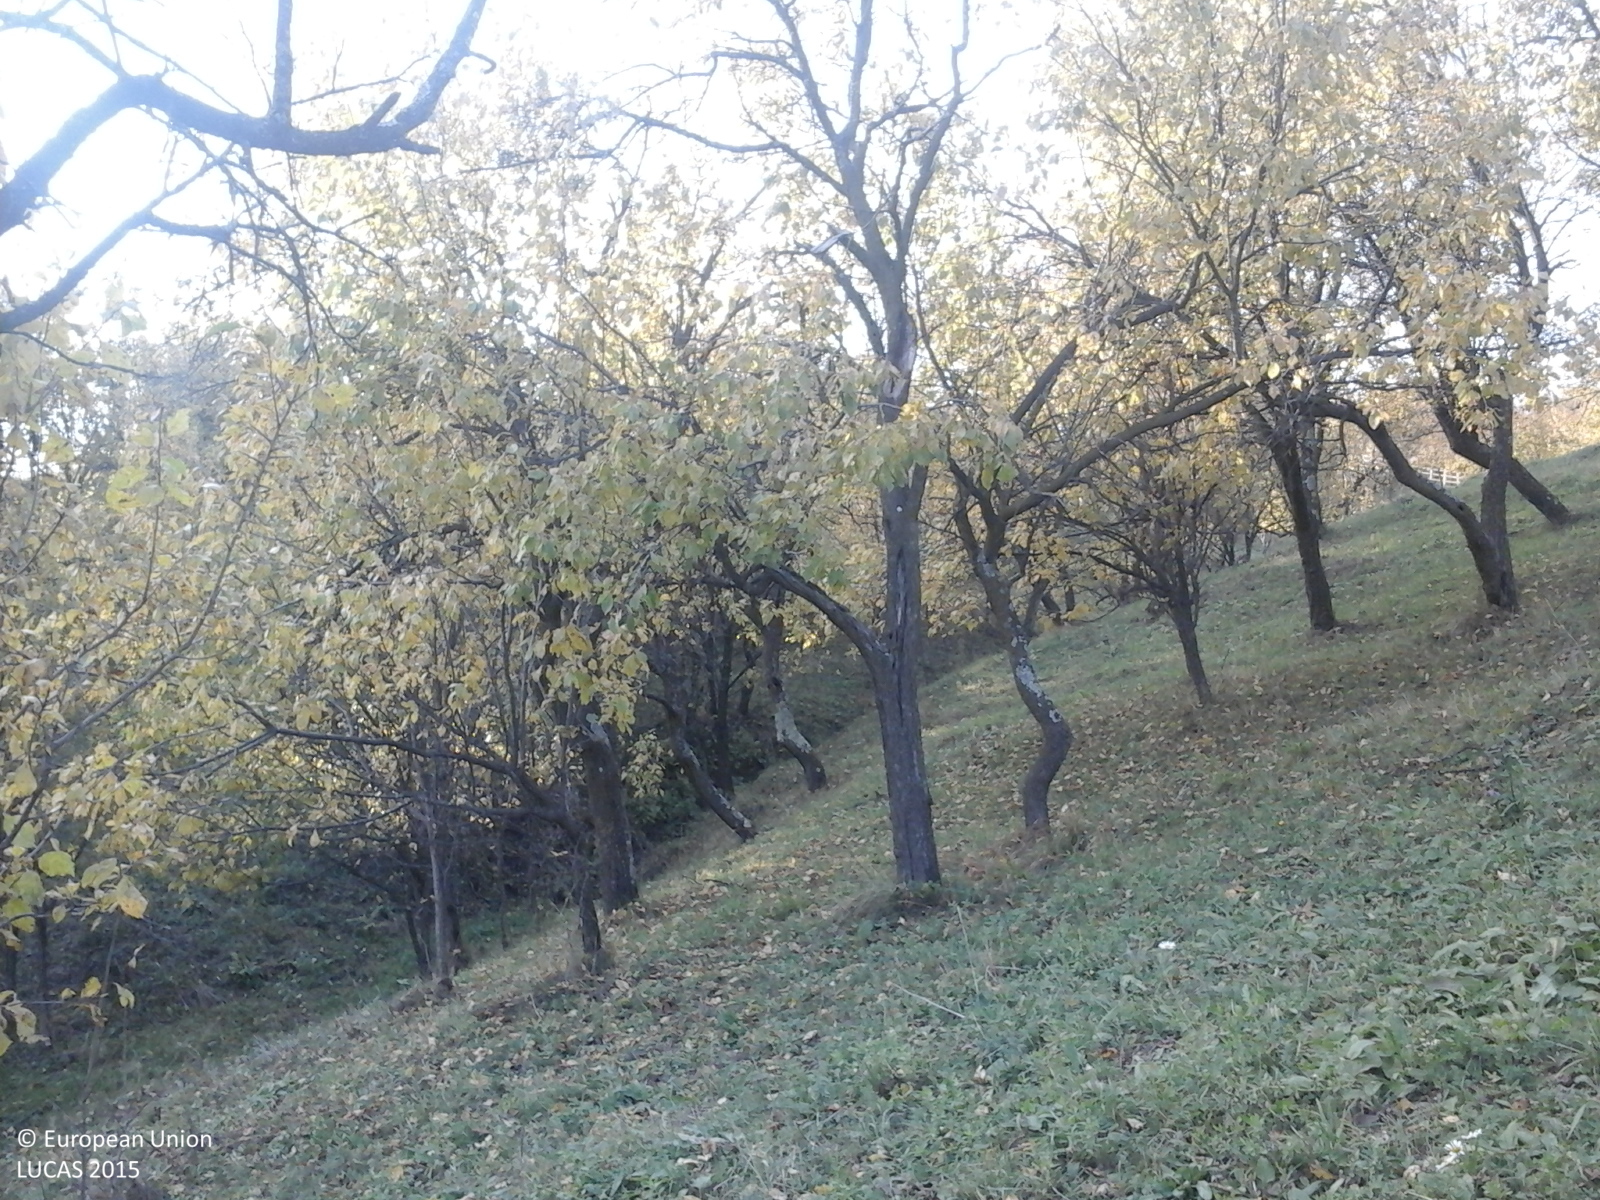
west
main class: Cropland
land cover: Other fruit trees and berries
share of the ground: > 75 %
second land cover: Grassland without tree/shrub cover
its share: > 75 %
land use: Agriculture (excluding fallow land and kitchen gardens)
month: October
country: RO
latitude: 45.5089
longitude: 26.7856
